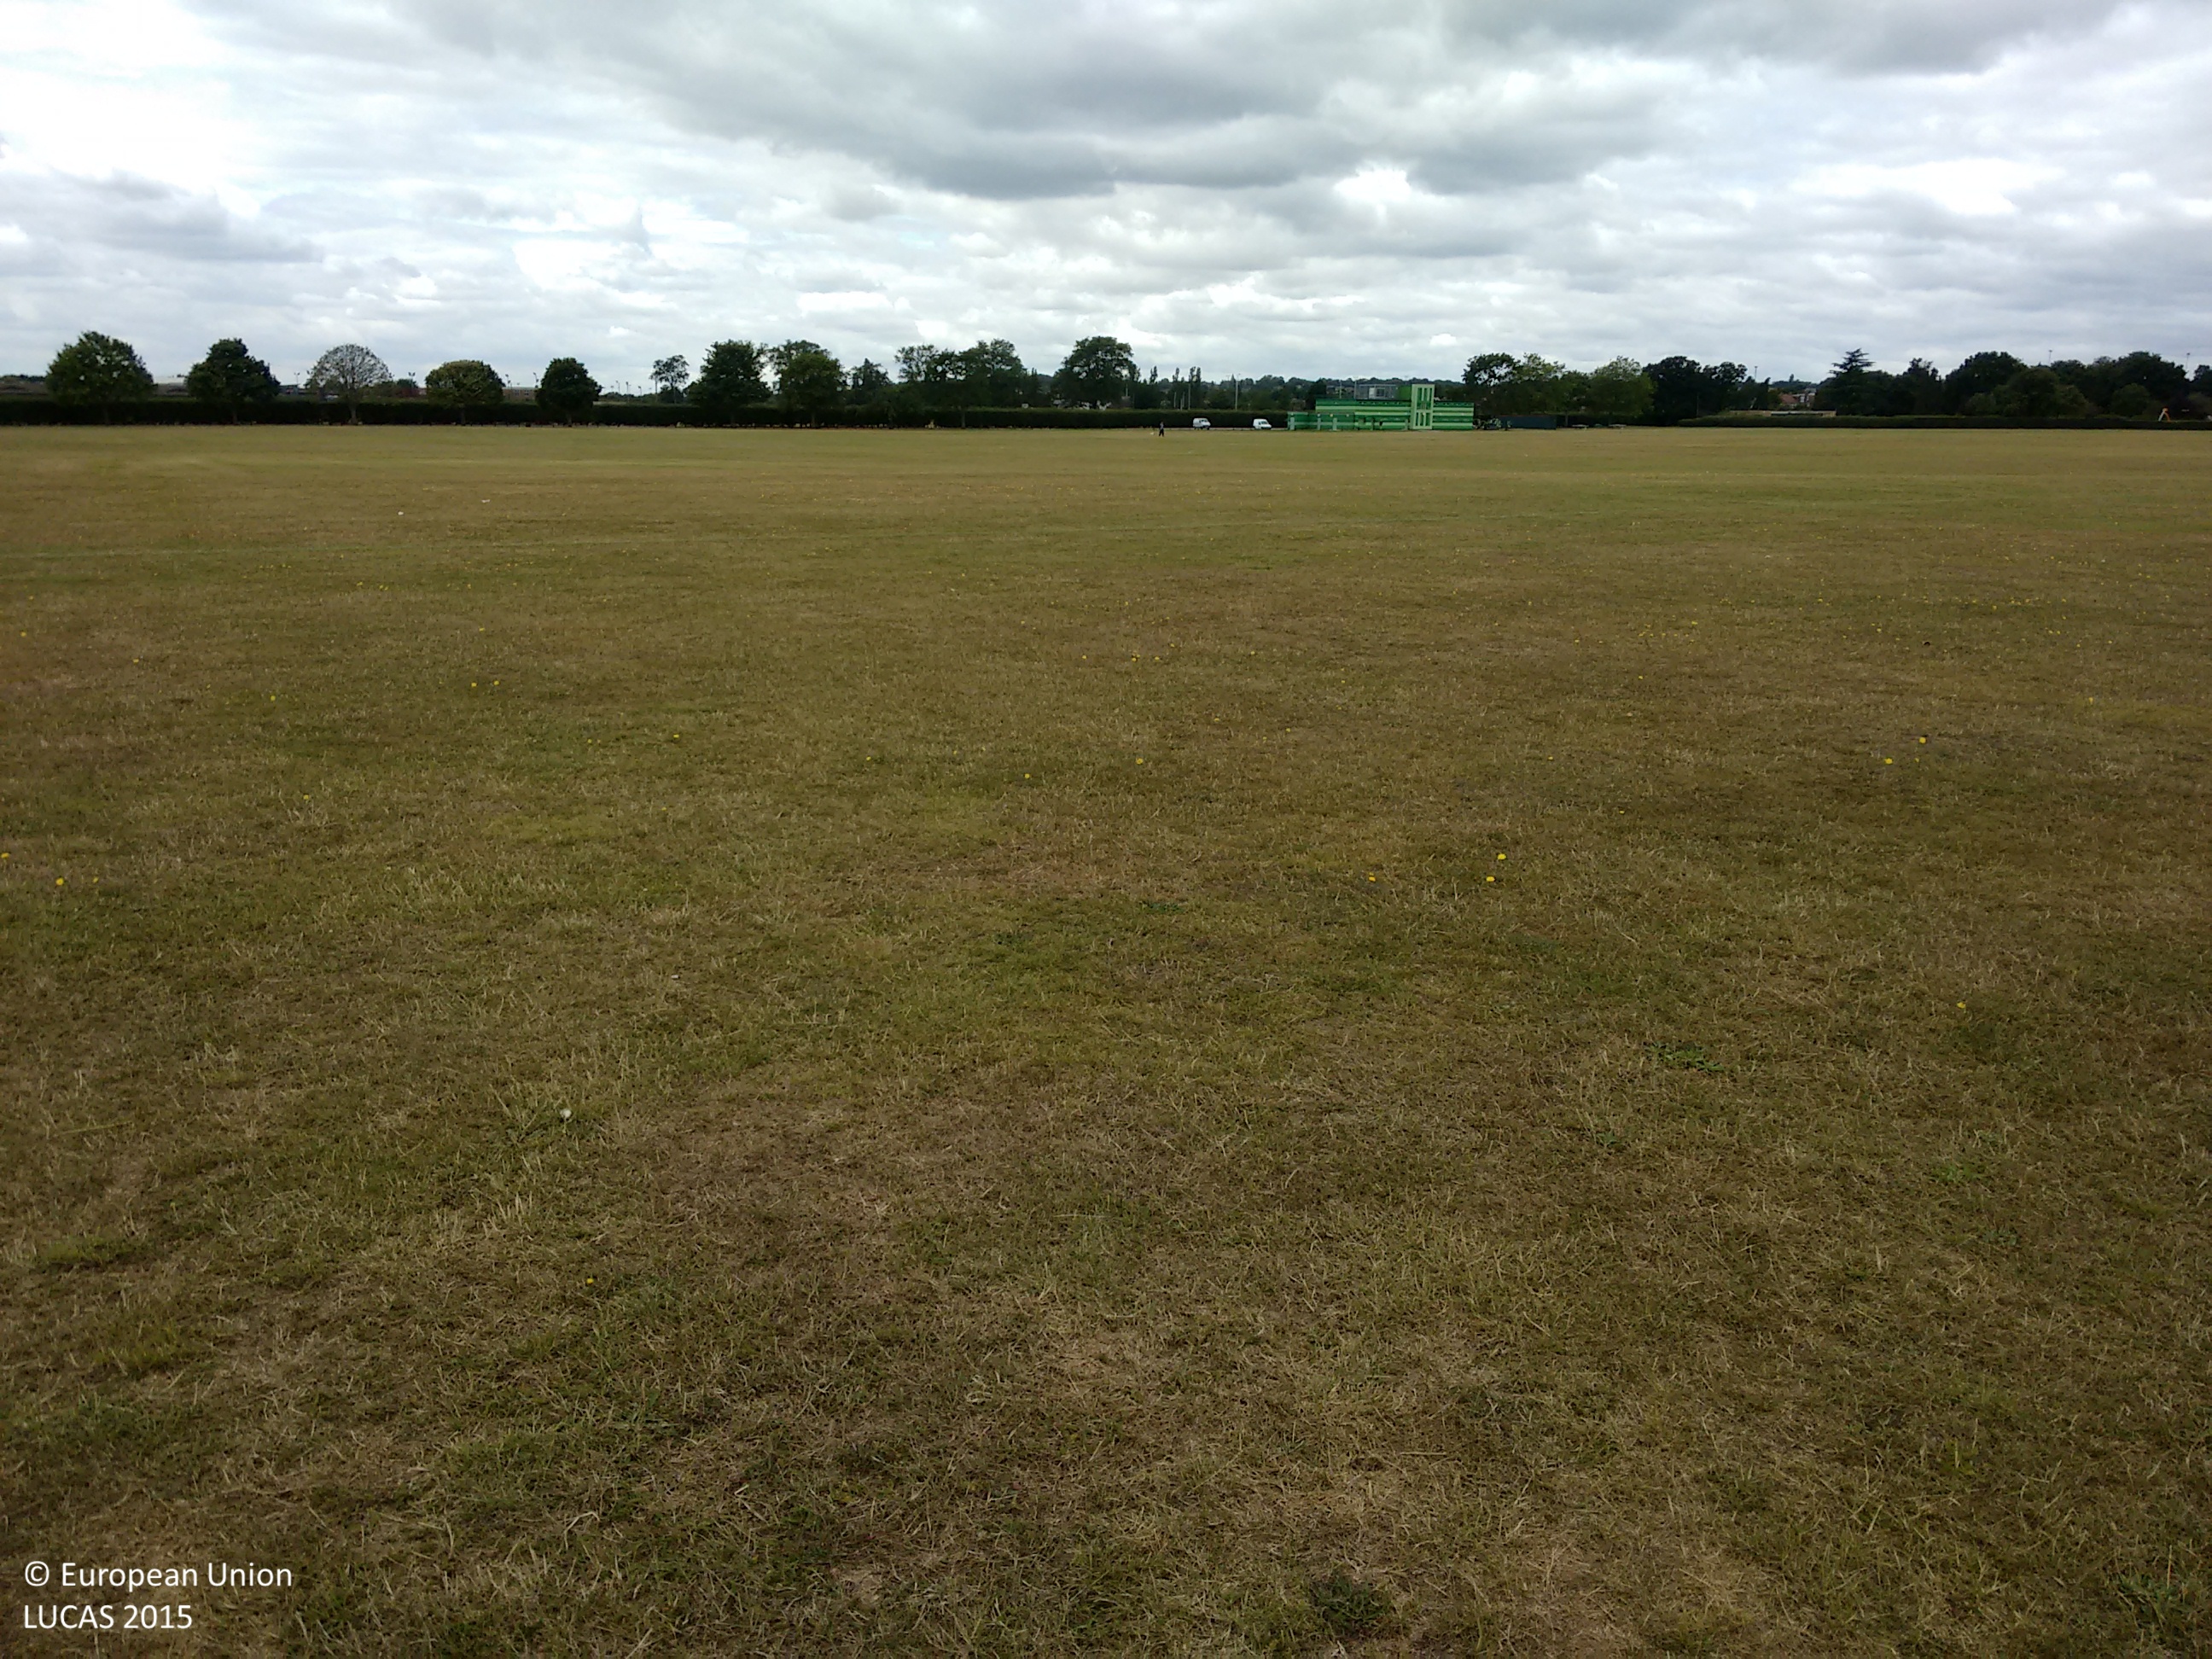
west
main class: Grassland
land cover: Grassland without tree/shrub cover
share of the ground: > 75 %
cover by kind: herbaceous plants 100 %
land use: Sport
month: July
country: GB
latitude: 51.6010
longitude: 0.1075
